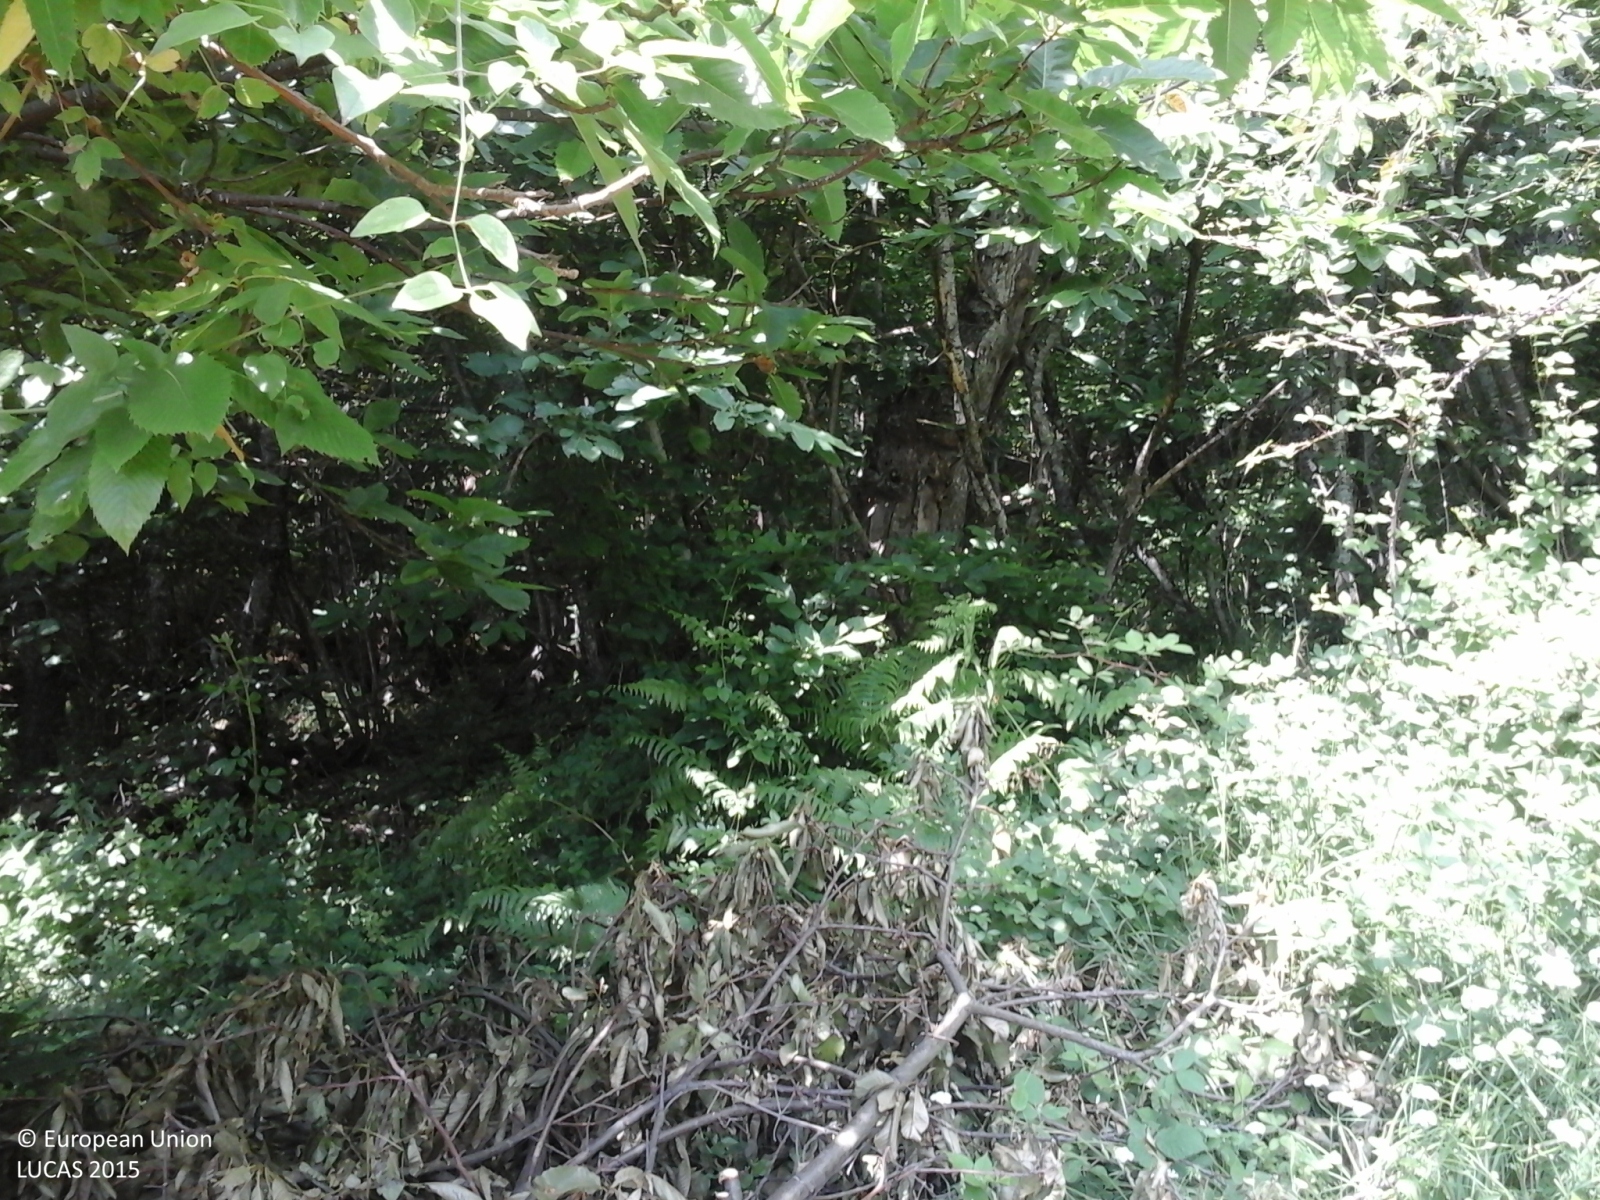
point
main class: Woodland
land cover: Broadleaved woodland
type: thermophilous deciduous forest
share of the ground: > 75 %
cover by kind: broadleaved forest trees 100 %
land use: Forestry
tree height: > 5 m
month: June
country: IT
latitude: 44.0928
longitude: 11.0342
